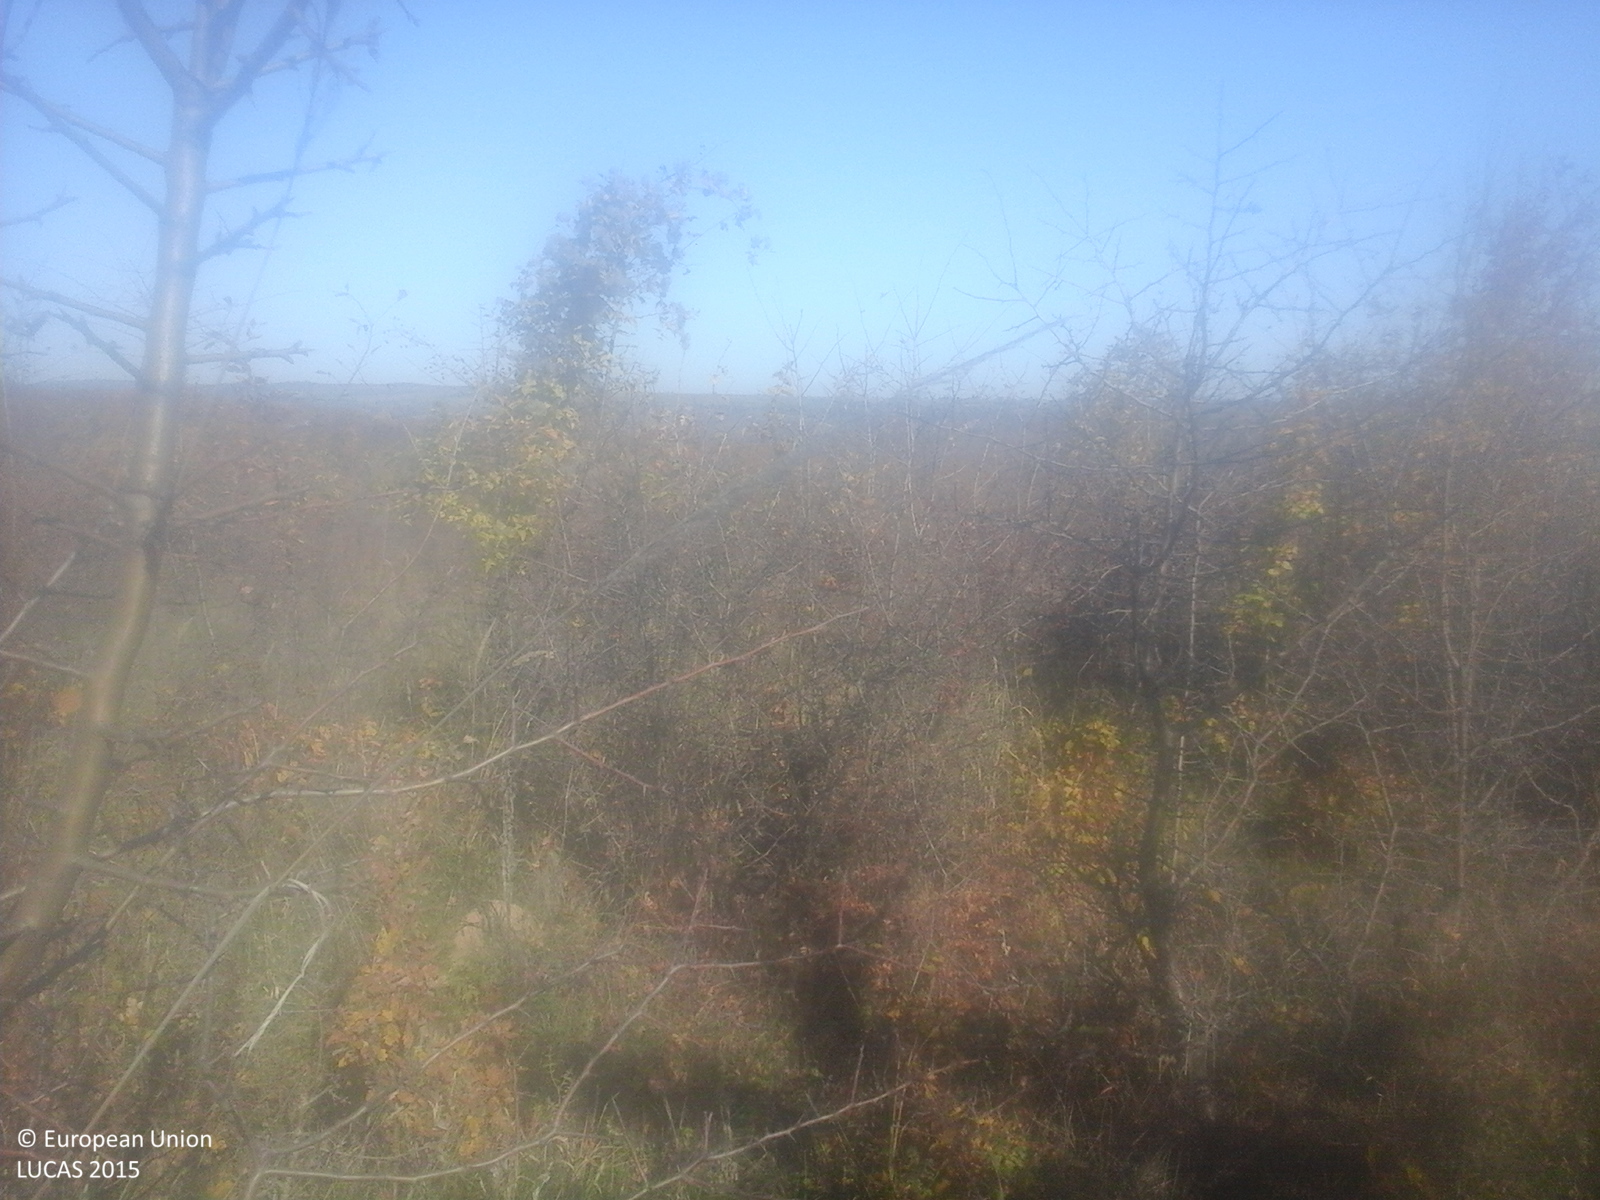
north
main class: Shrubland
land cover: Shrubland with sparse tree cover
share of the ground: > 75 %
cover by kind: shrubs 70 %, herbaceous plants 25 %, broadleaved forest trees 5 %
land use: Agriculture (excluding fallow land and kitchen gardens)
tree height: < 5 m
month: October
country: RO
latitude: 45.9124
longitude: 27.0192
